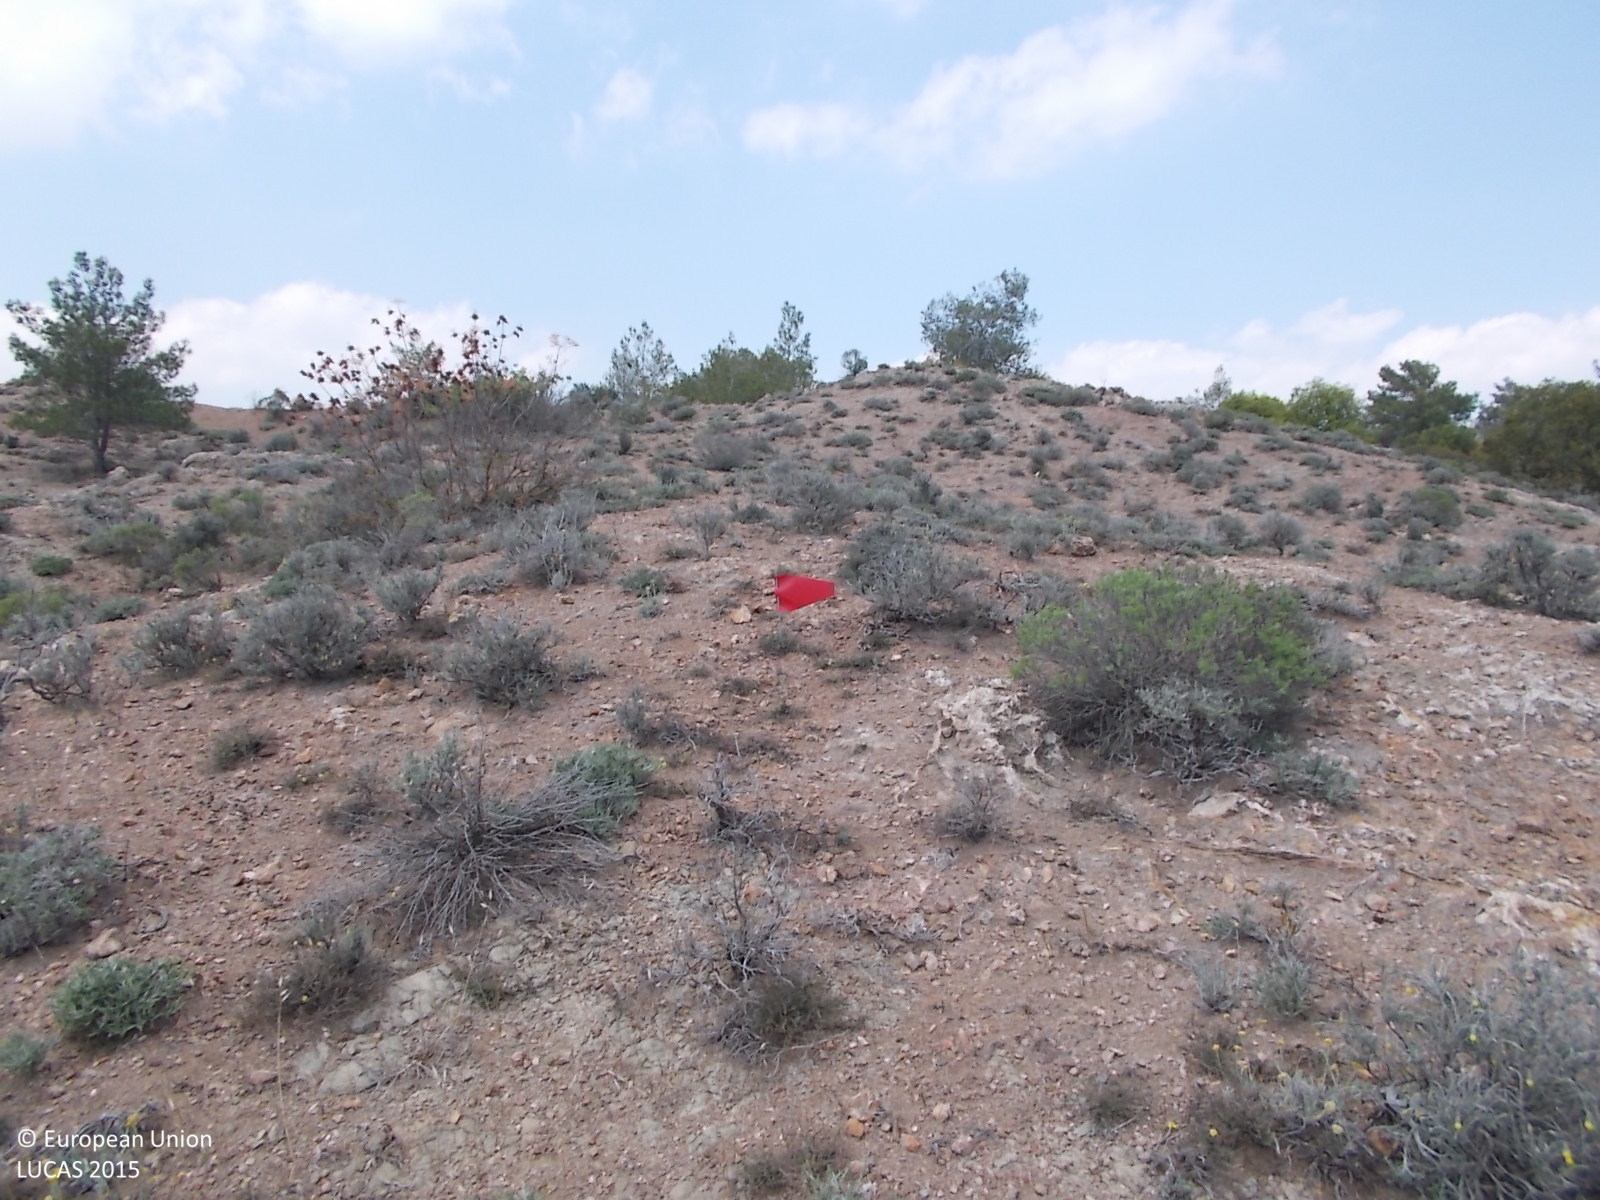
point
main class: Shrubland
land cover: Shrubland without tree cover
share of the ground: 25 - 50 %
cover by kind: unconsolidated bare surface 50 %, shrubs 45 %, consolidated bare surface 5 %
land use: Semi-natural and natural areas not in use
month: April
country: CY
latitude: 34.9217
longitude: 33.4502
